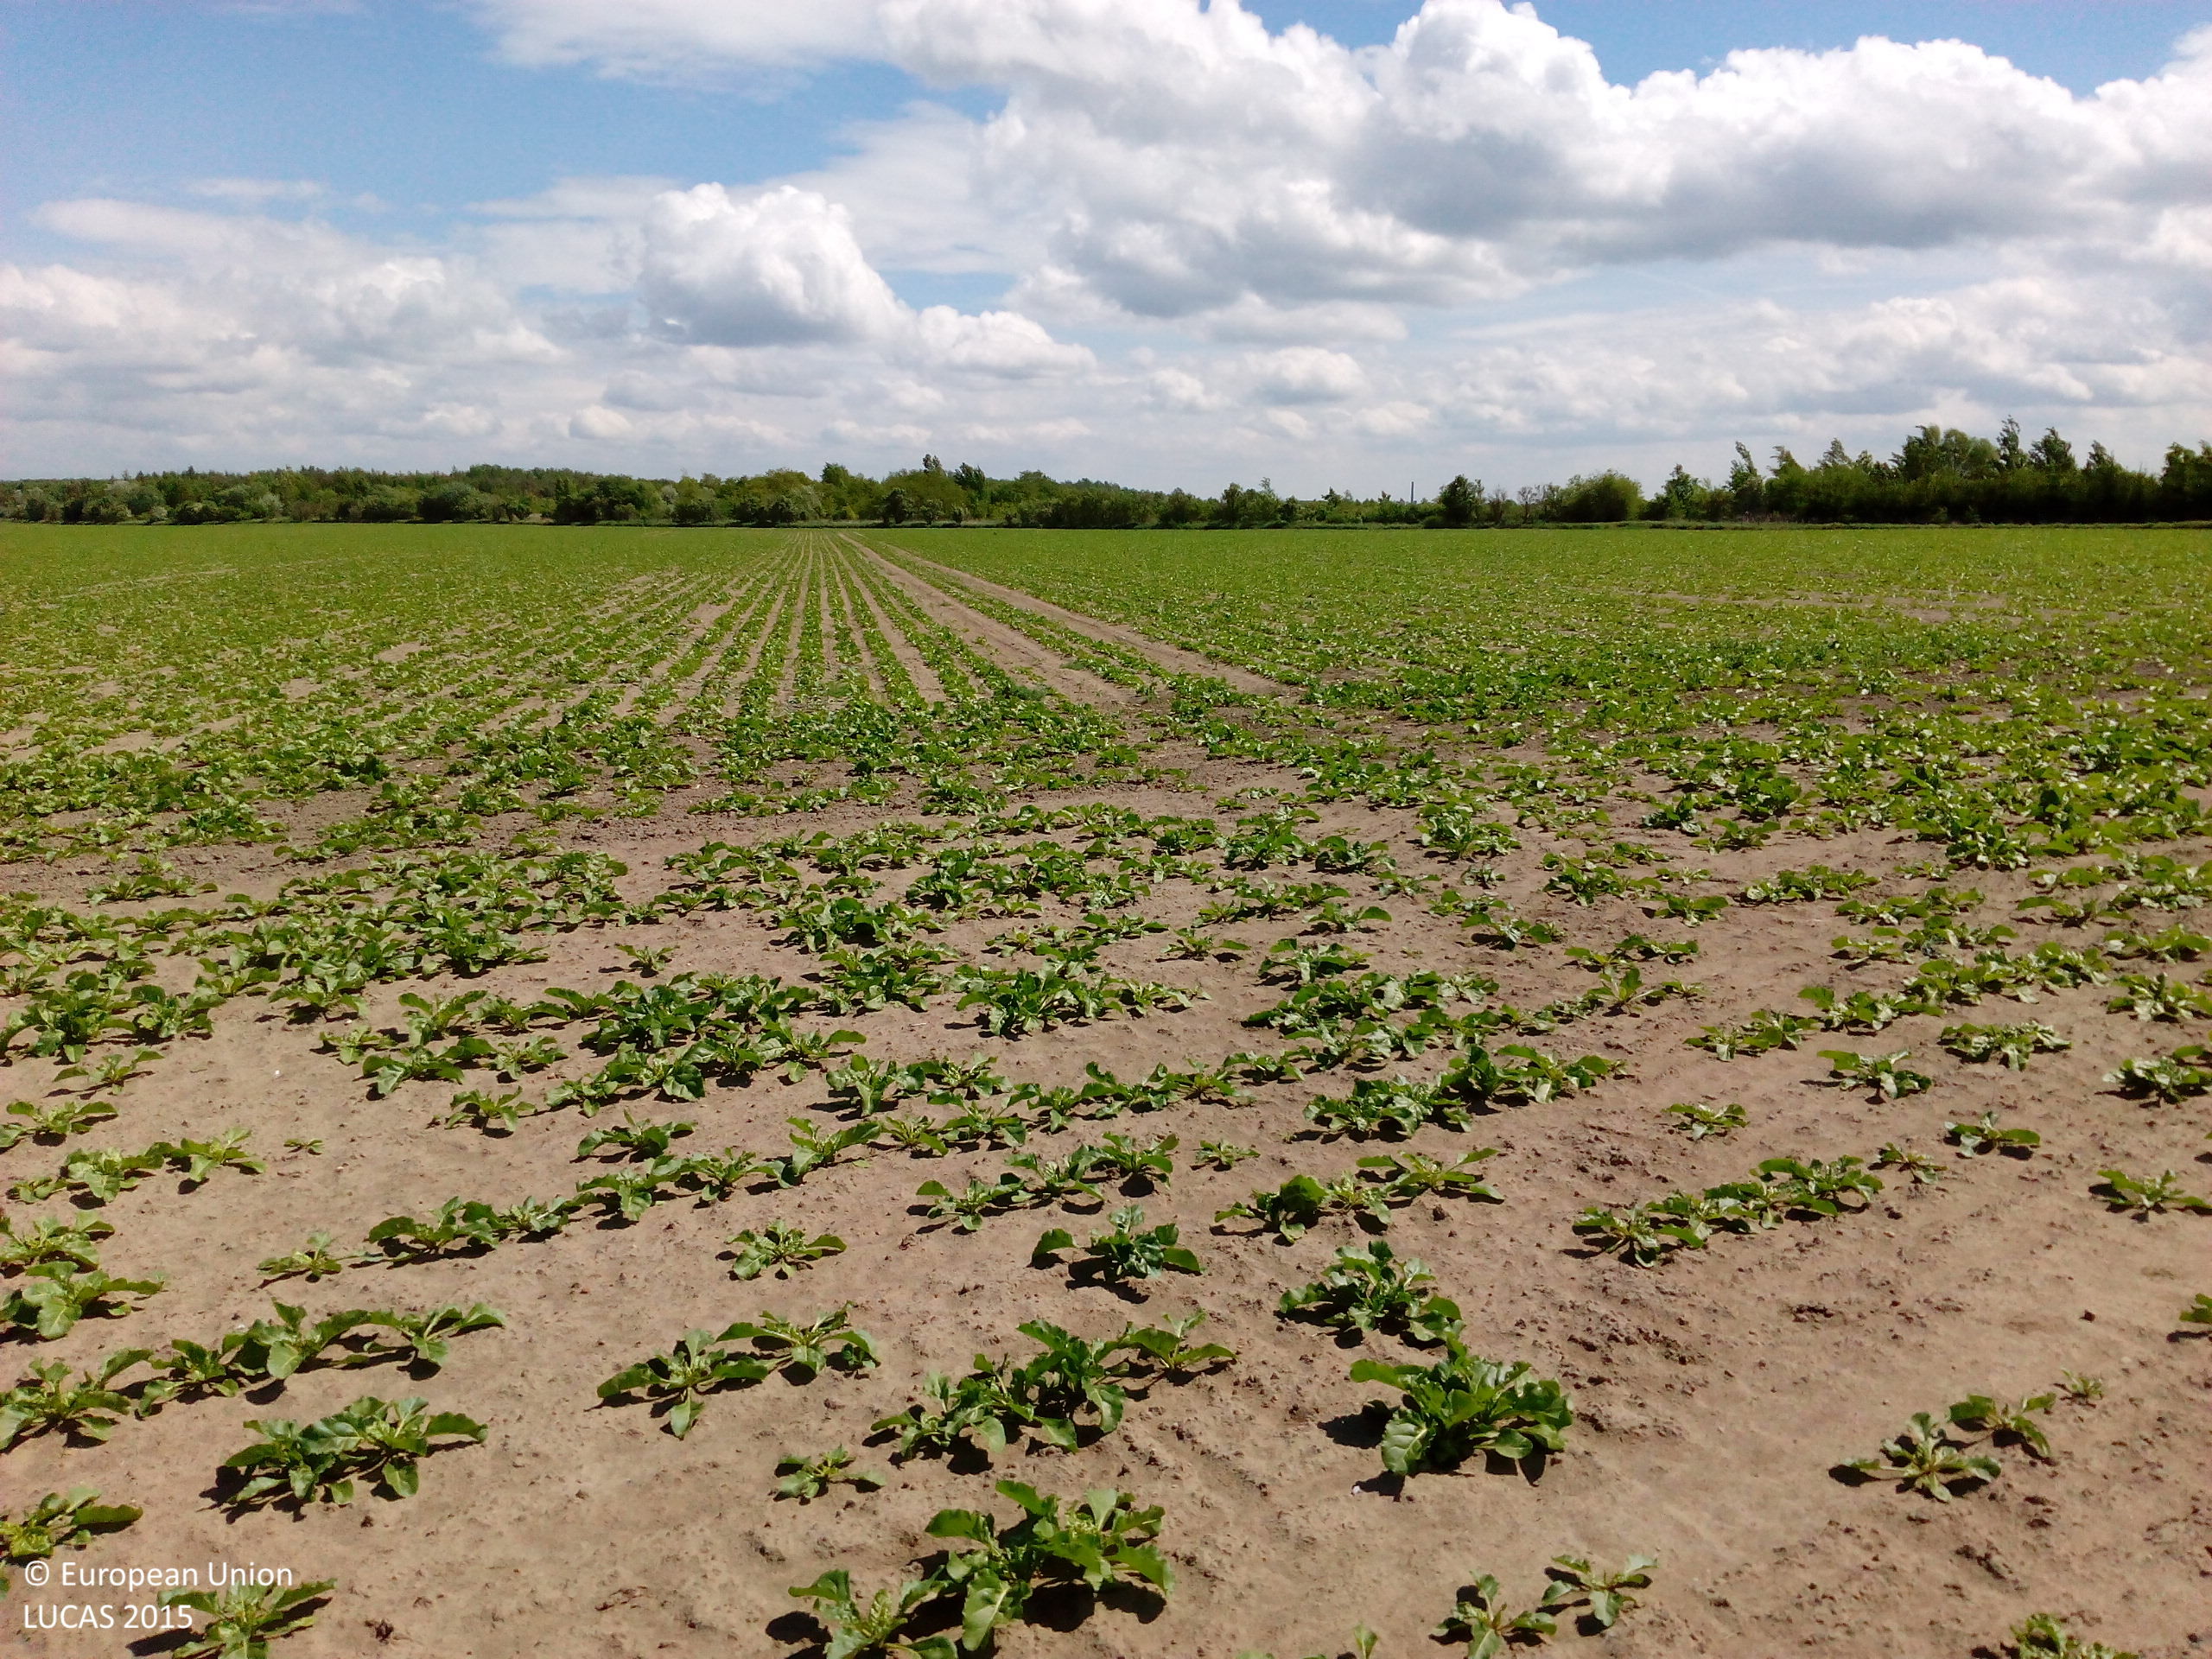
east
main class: Cropland
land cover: Sugar beet
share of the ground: 50 - 75 %
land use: Agriculture (excluding fallow land and kitchen gardens)
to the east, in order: Sugar beet; Shrubland with sparse tree cover; Paved roads, cycling and walking lanes; Lines of trees; Grassland with sparse tree/shrub cover
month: May
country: DE
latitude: 51.6197
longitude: 12.2095
